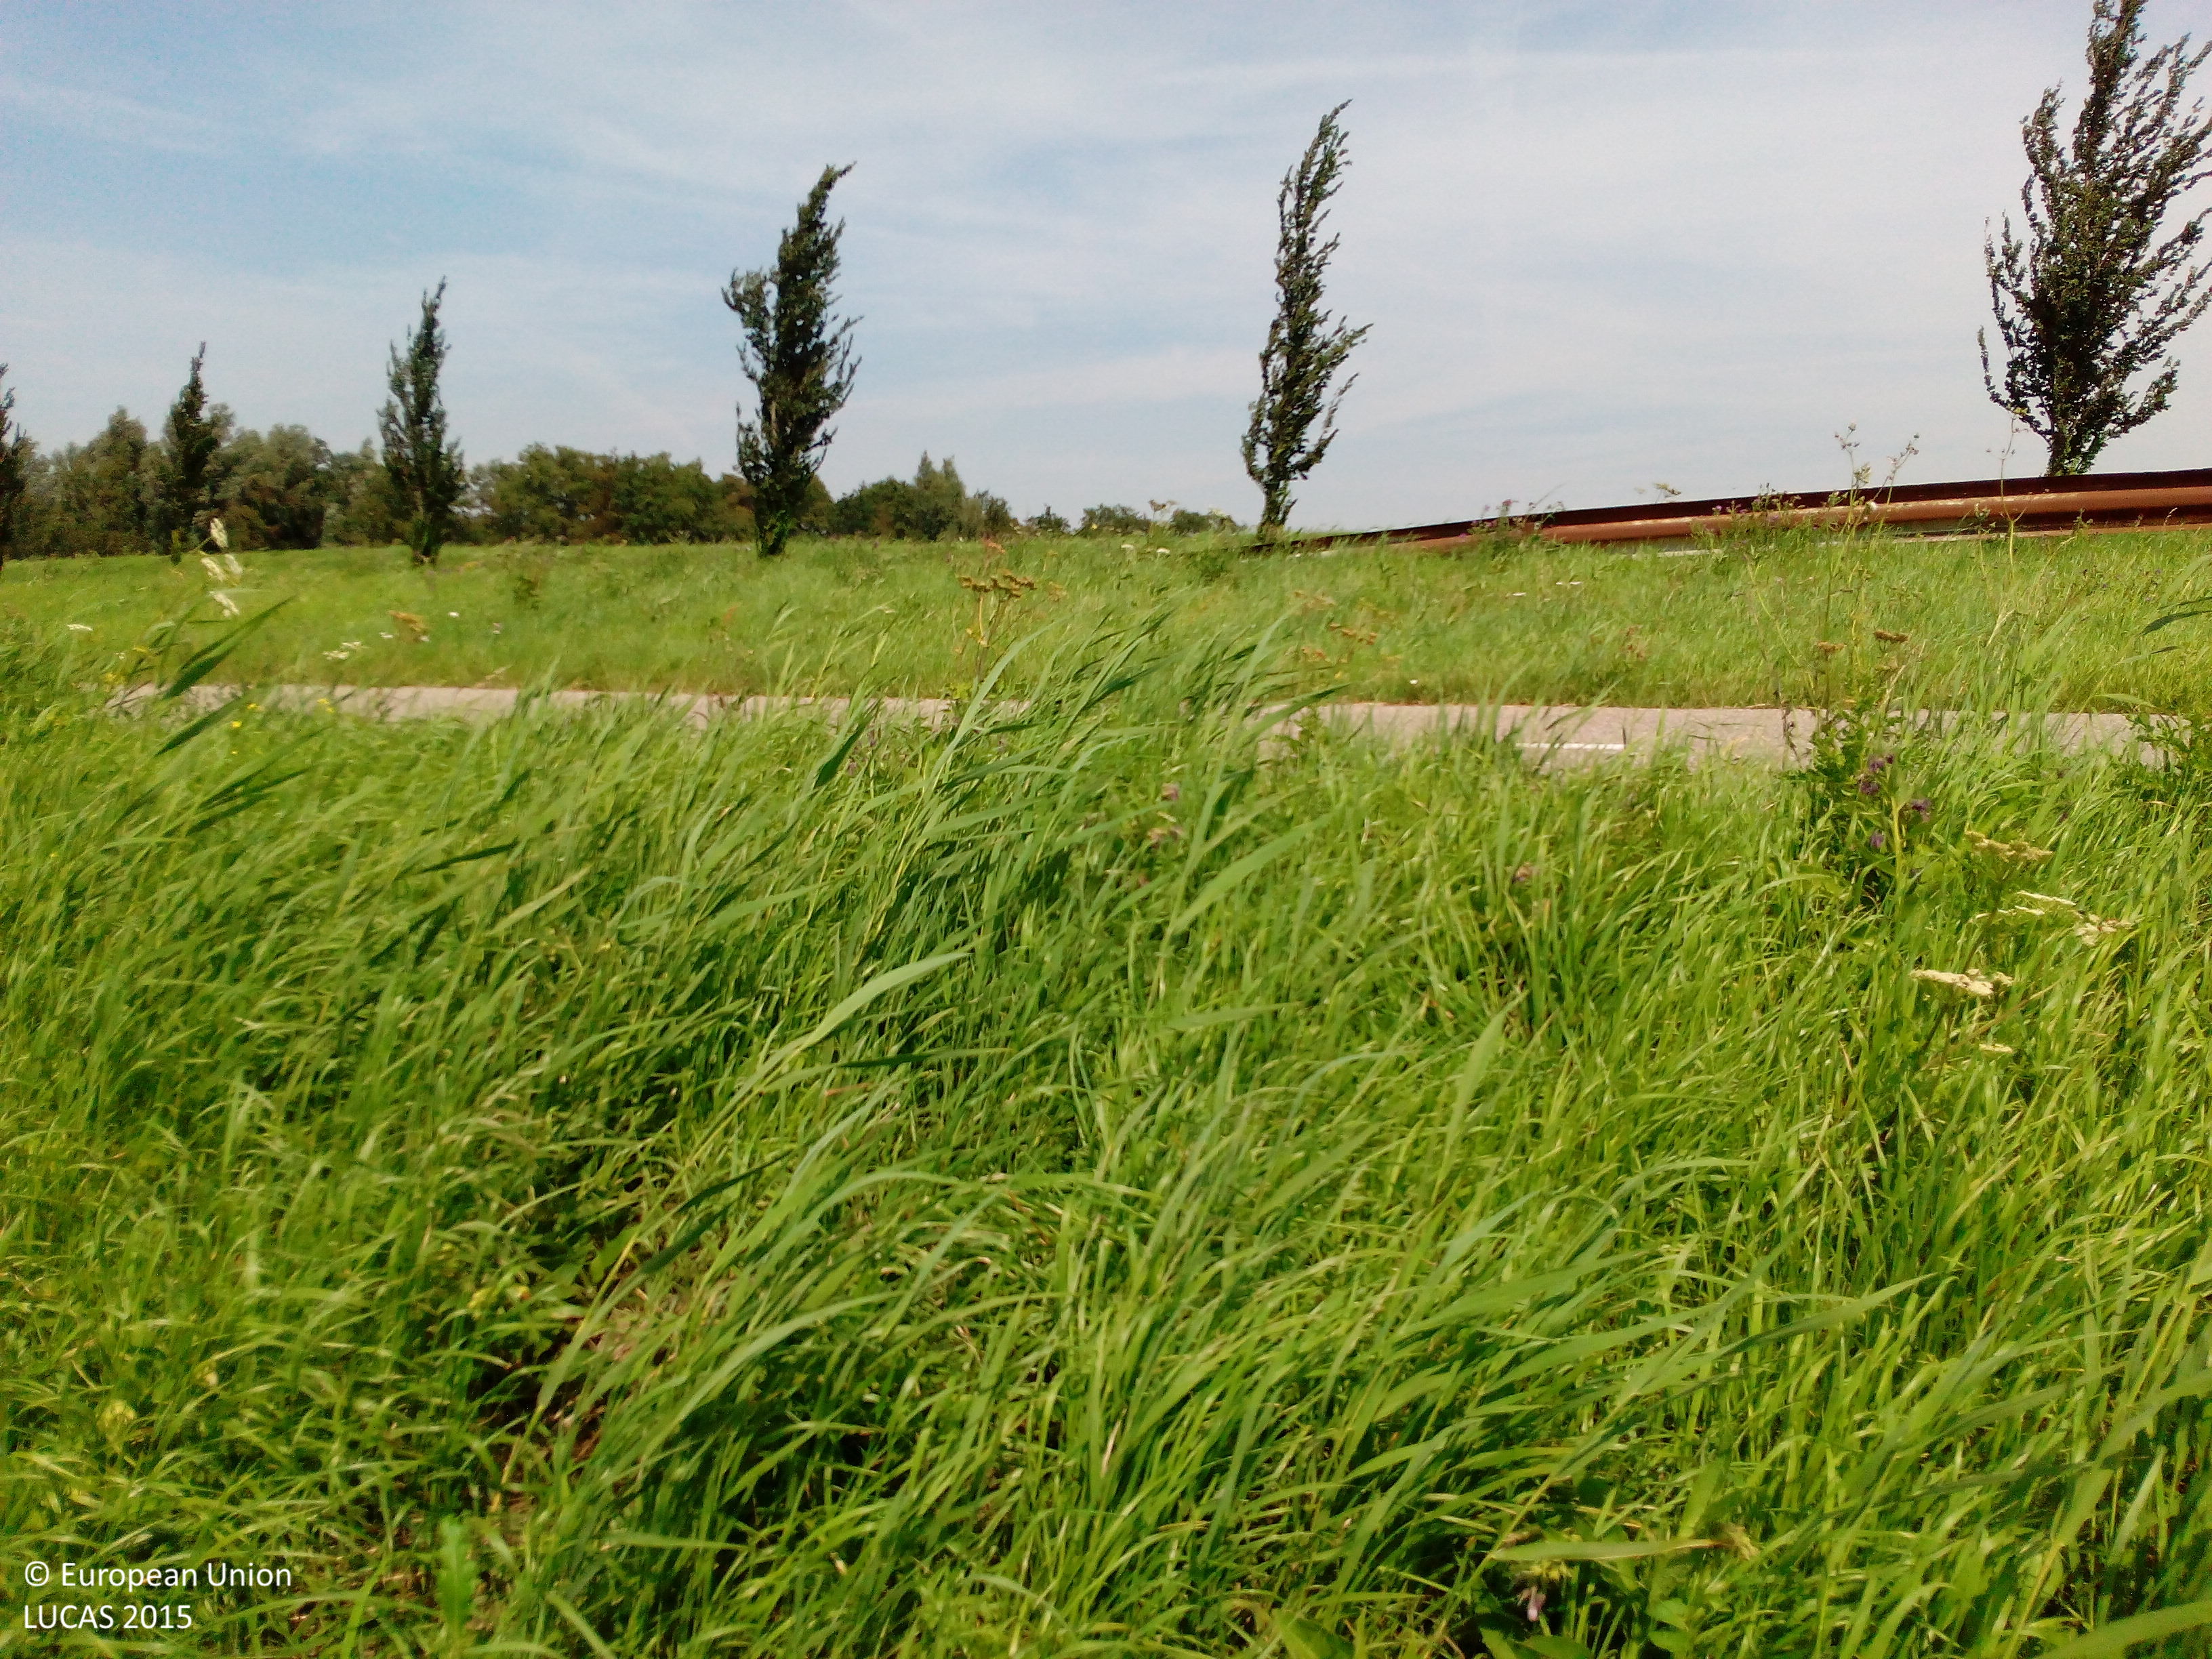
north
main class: Grassland
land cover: Grassland without tree/shrub cover
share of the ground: > 75 %
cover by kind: herbaceous plants 80 %, unconsolidated bare surface 20 %
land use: Agriculture (excluding fallow land and kitchen gardens)
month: August
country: NL
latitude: 52.0060
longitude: 4.6792
